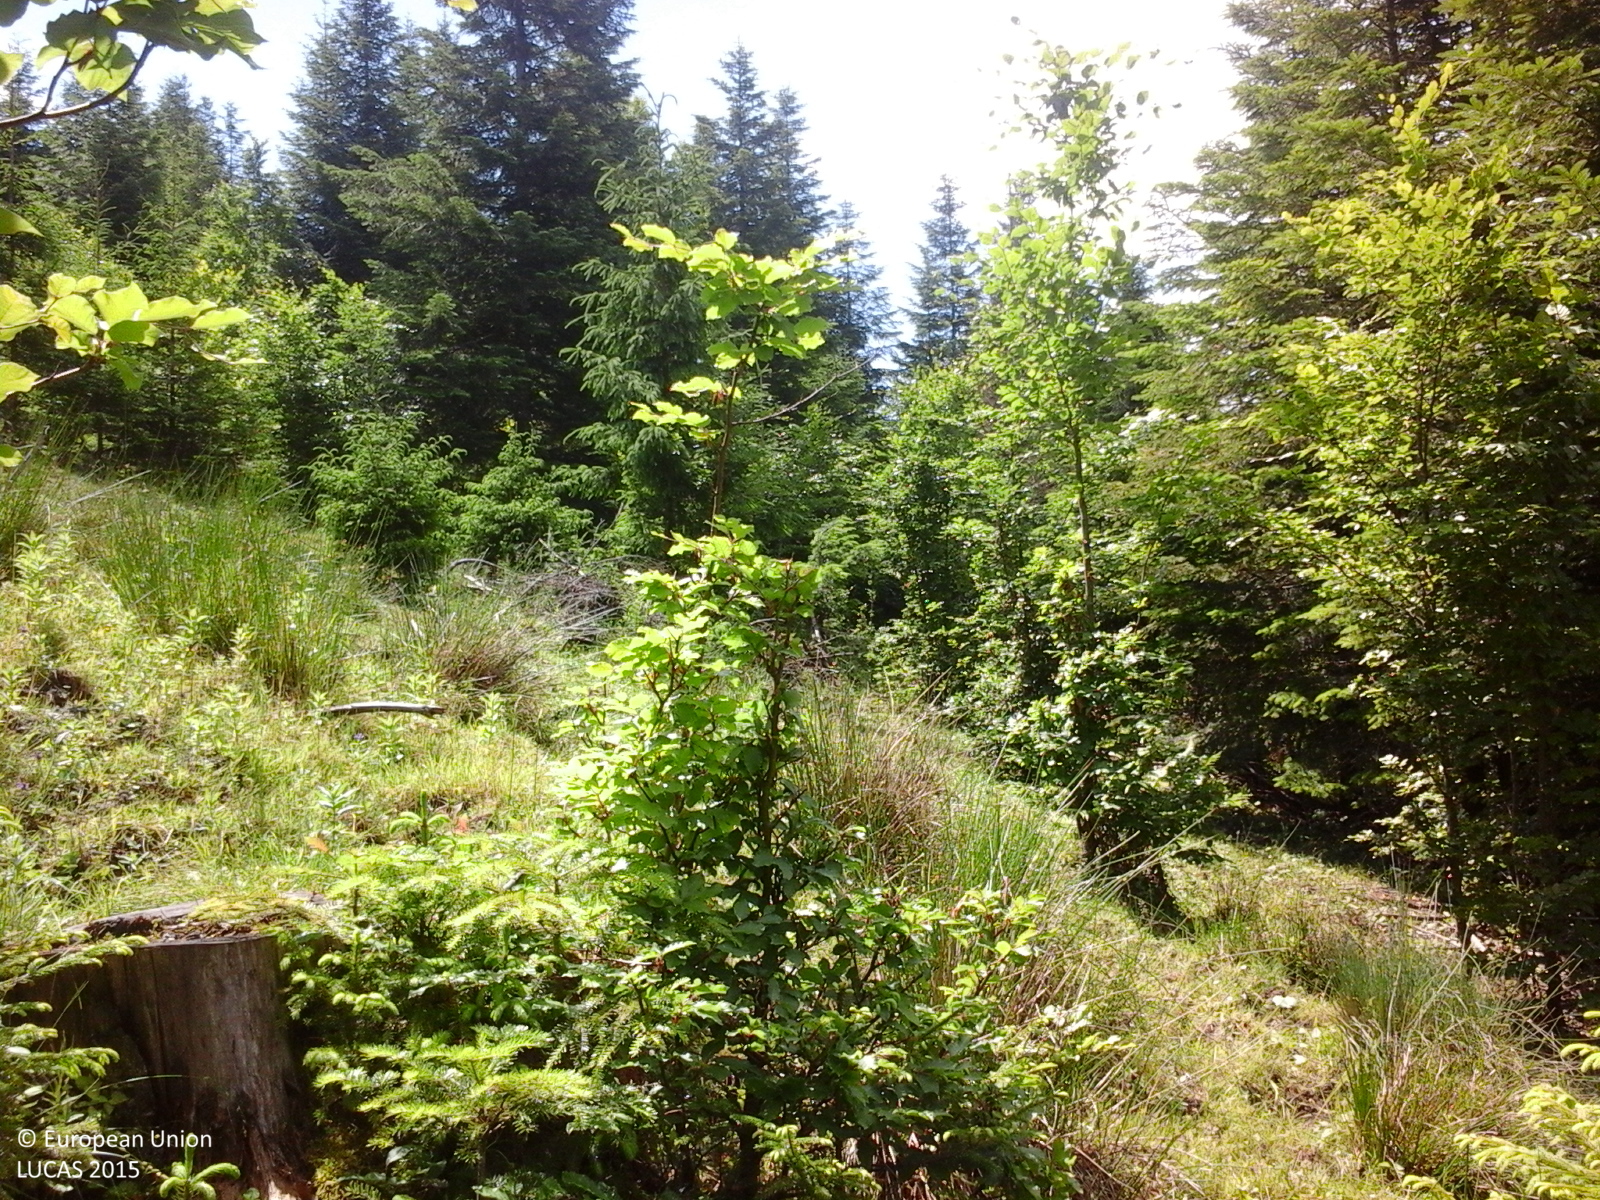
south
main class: Woodland
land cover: Spruce dominated coniferous woodland
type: alpine coniferous forest
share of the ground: > 75 %
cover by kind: coniferous forest trees 95 %, broadleaved forest trees 5 %
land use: Forestry
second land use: Agriculture (excluding fallow land and kitchen gardens)
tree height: > 5 m
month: June
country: RO
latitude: 47.6507
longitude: 25.4938
